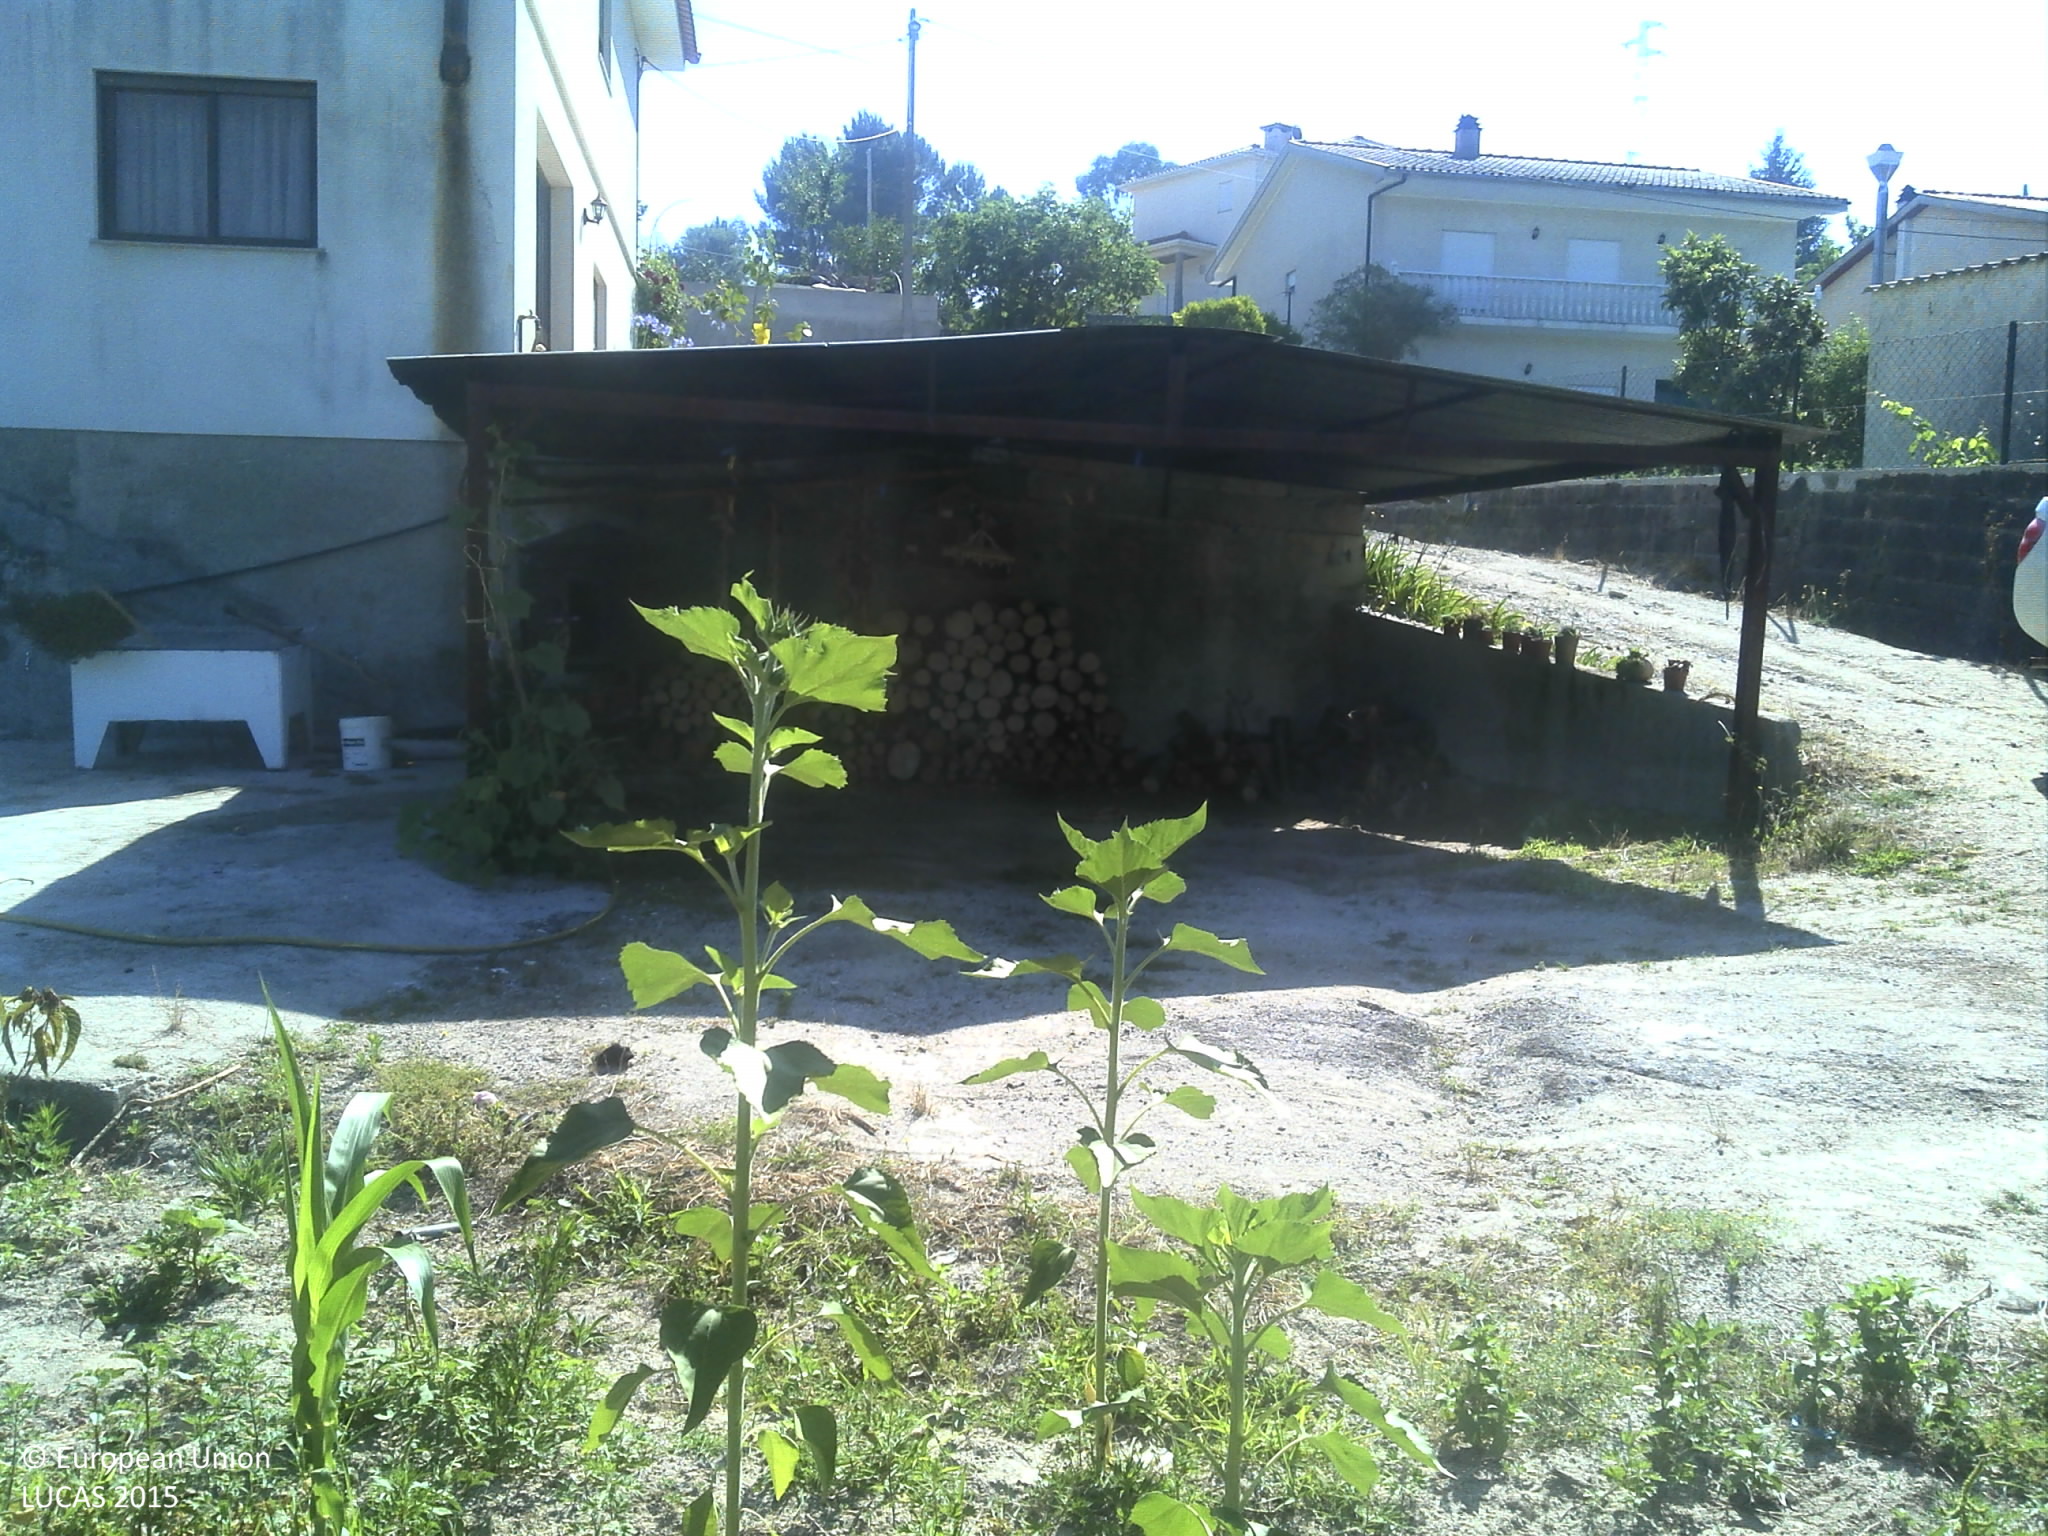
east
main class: Cropland
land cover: Other fresh vegetables
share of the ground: 25 - 50 %
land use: Kitchen garden
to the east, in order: Other fresh vegetables; Artificial constructions in urban areas; Vineyards; Other fresh vegetables; Artificial constructions in urban areas
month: June
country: PT
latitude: 41.2999
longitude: -8.1146
